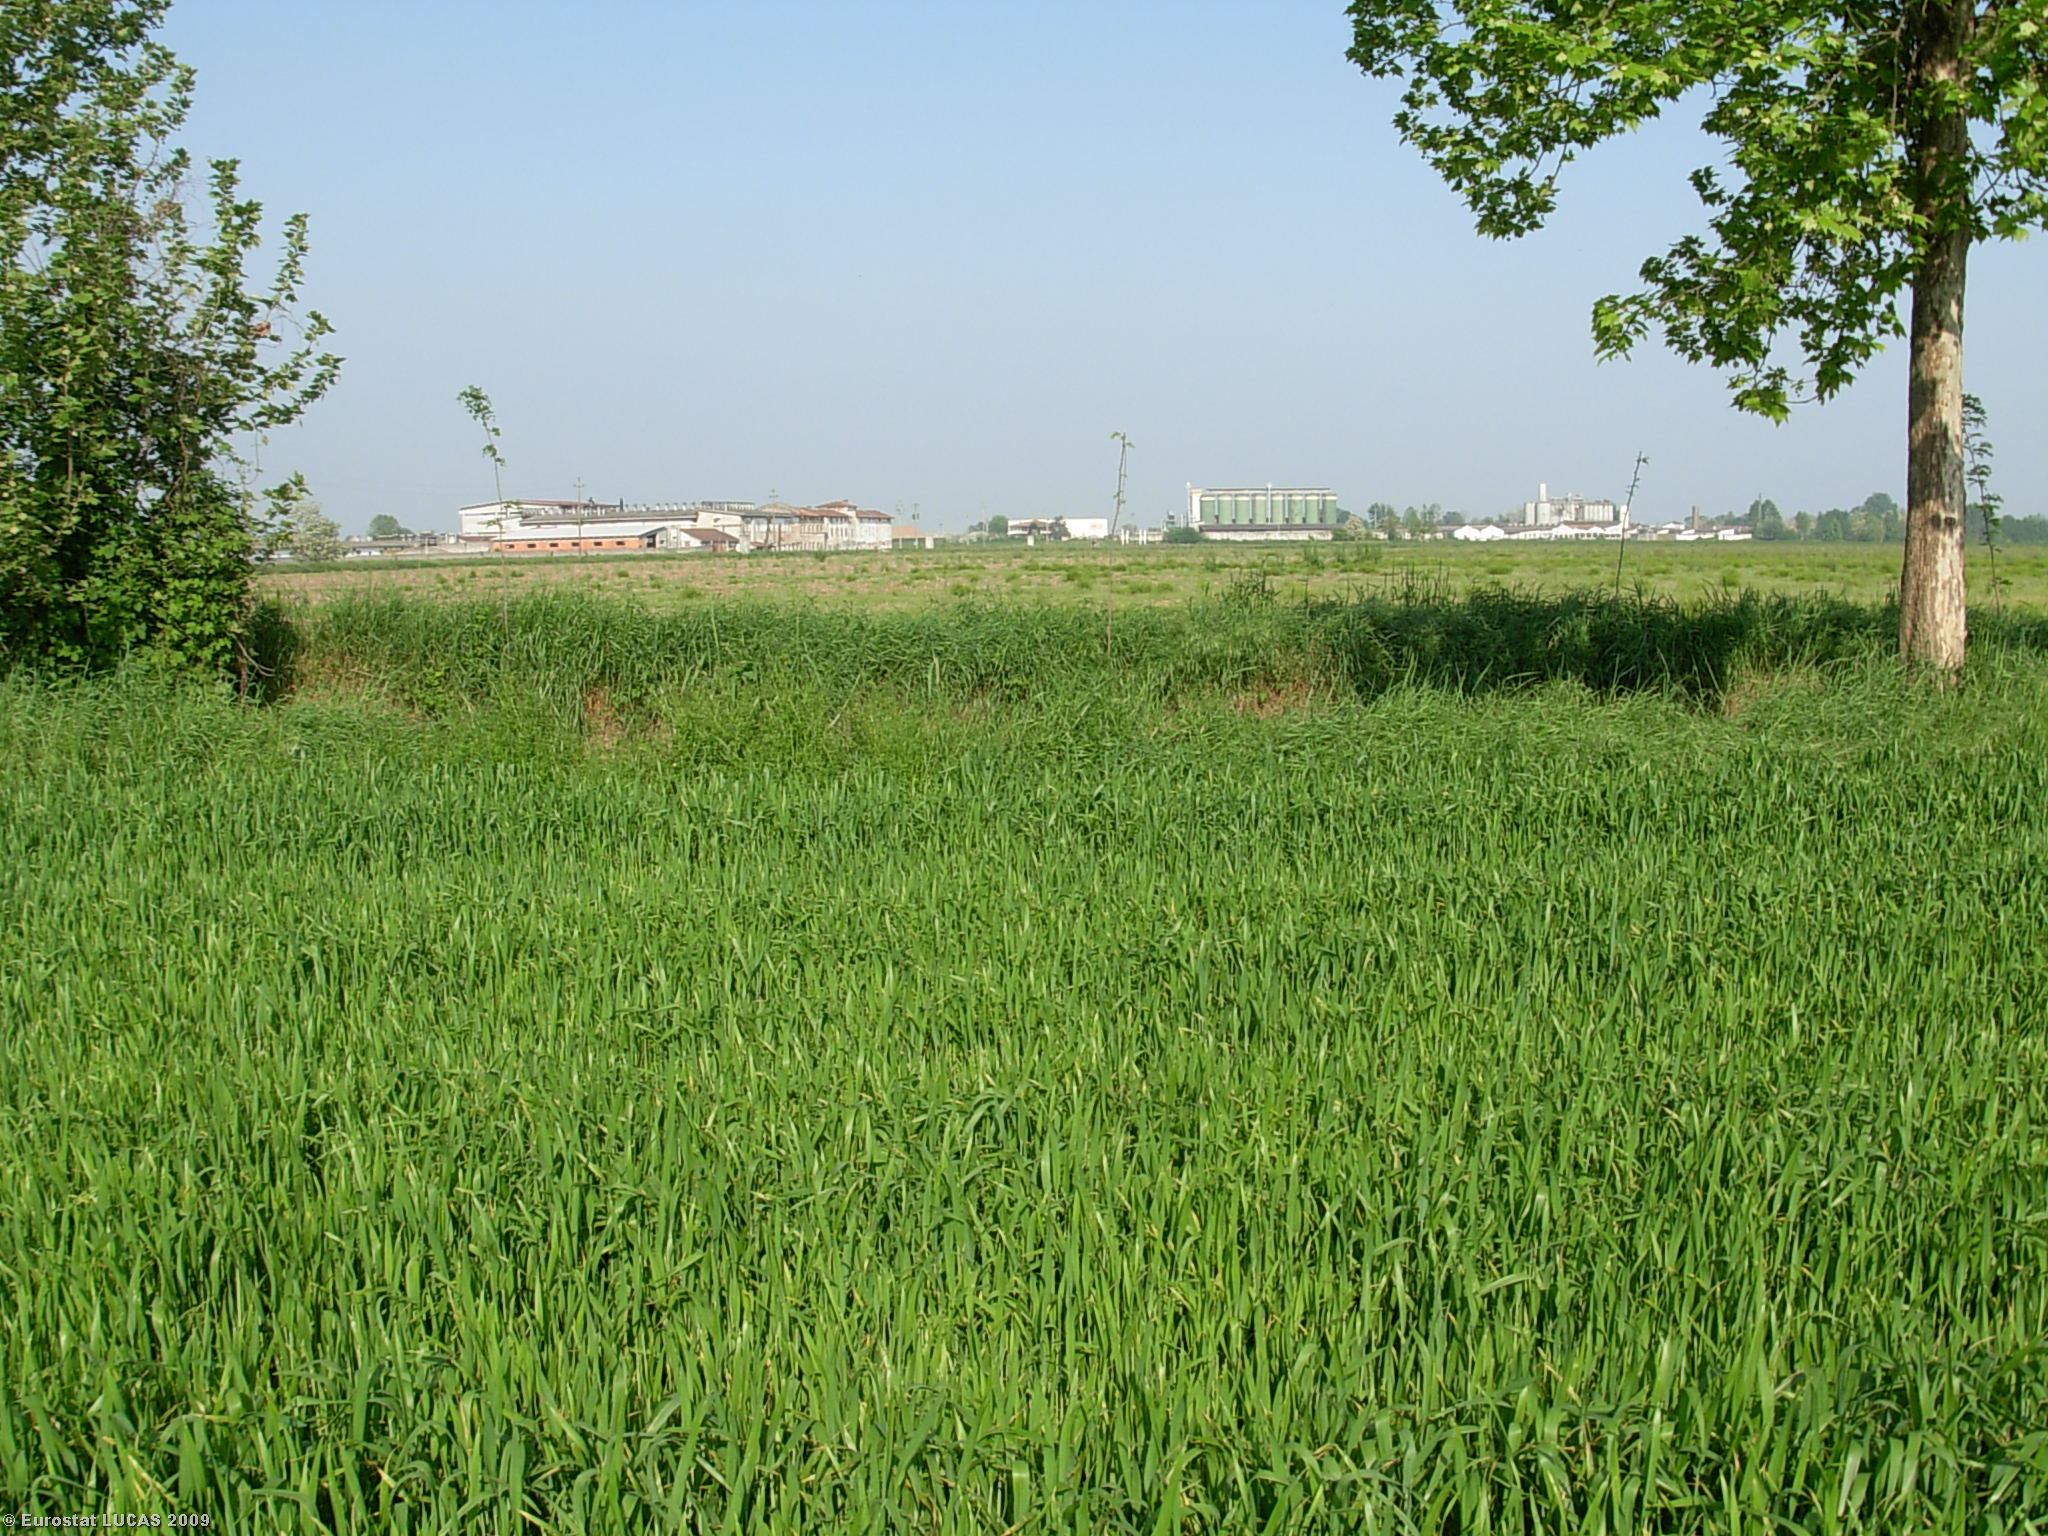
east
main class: Cropland
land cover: Common wheat
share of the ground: > 75 %
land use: Agriculture (excluding fallow land and kitchen gardens)
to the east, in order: Common wheat; Grass margins; Ditches and canals; Managed hedges; Spontaneously vegetated surfaces
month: May
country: IT
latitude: 45.2698
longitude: 10.2672
